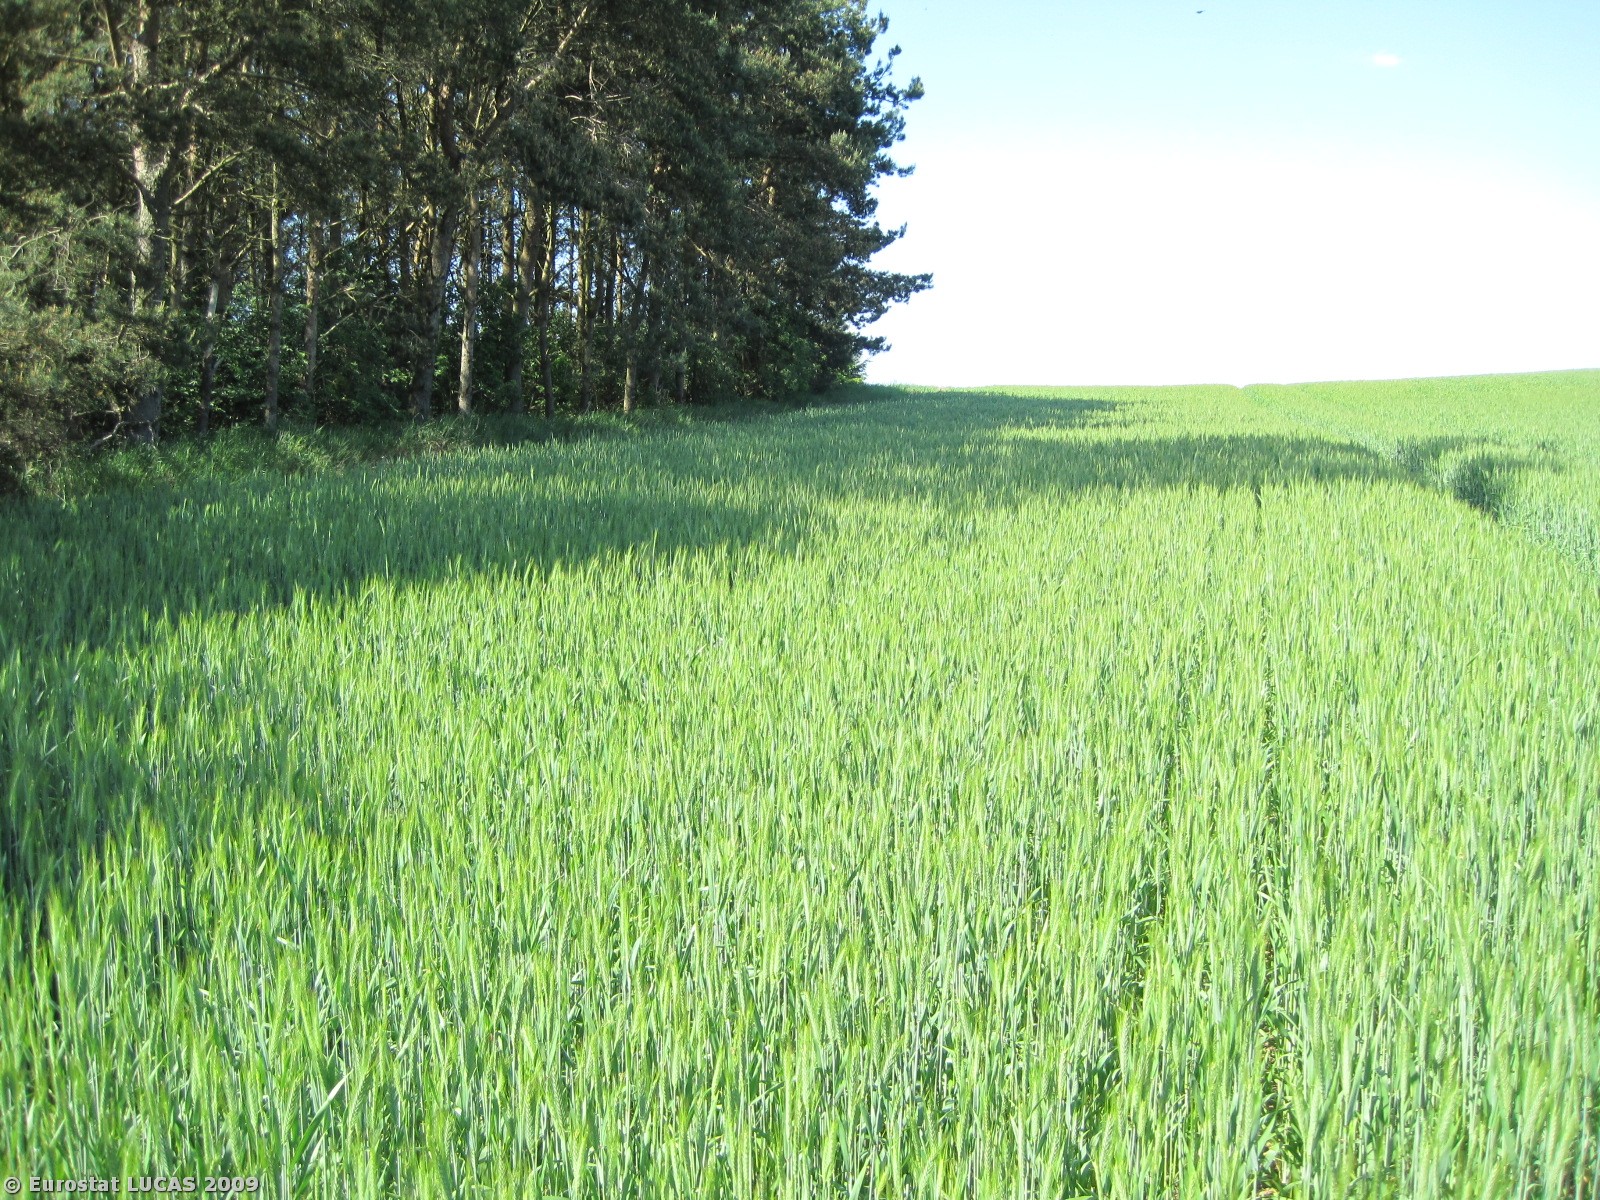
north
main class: Cropland
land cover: Barley
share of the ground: > 75 %
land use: Agriculture (excluding fallow land and kitchen gardens)
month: May
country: DK
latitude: 56.4572
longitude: 10.2107
